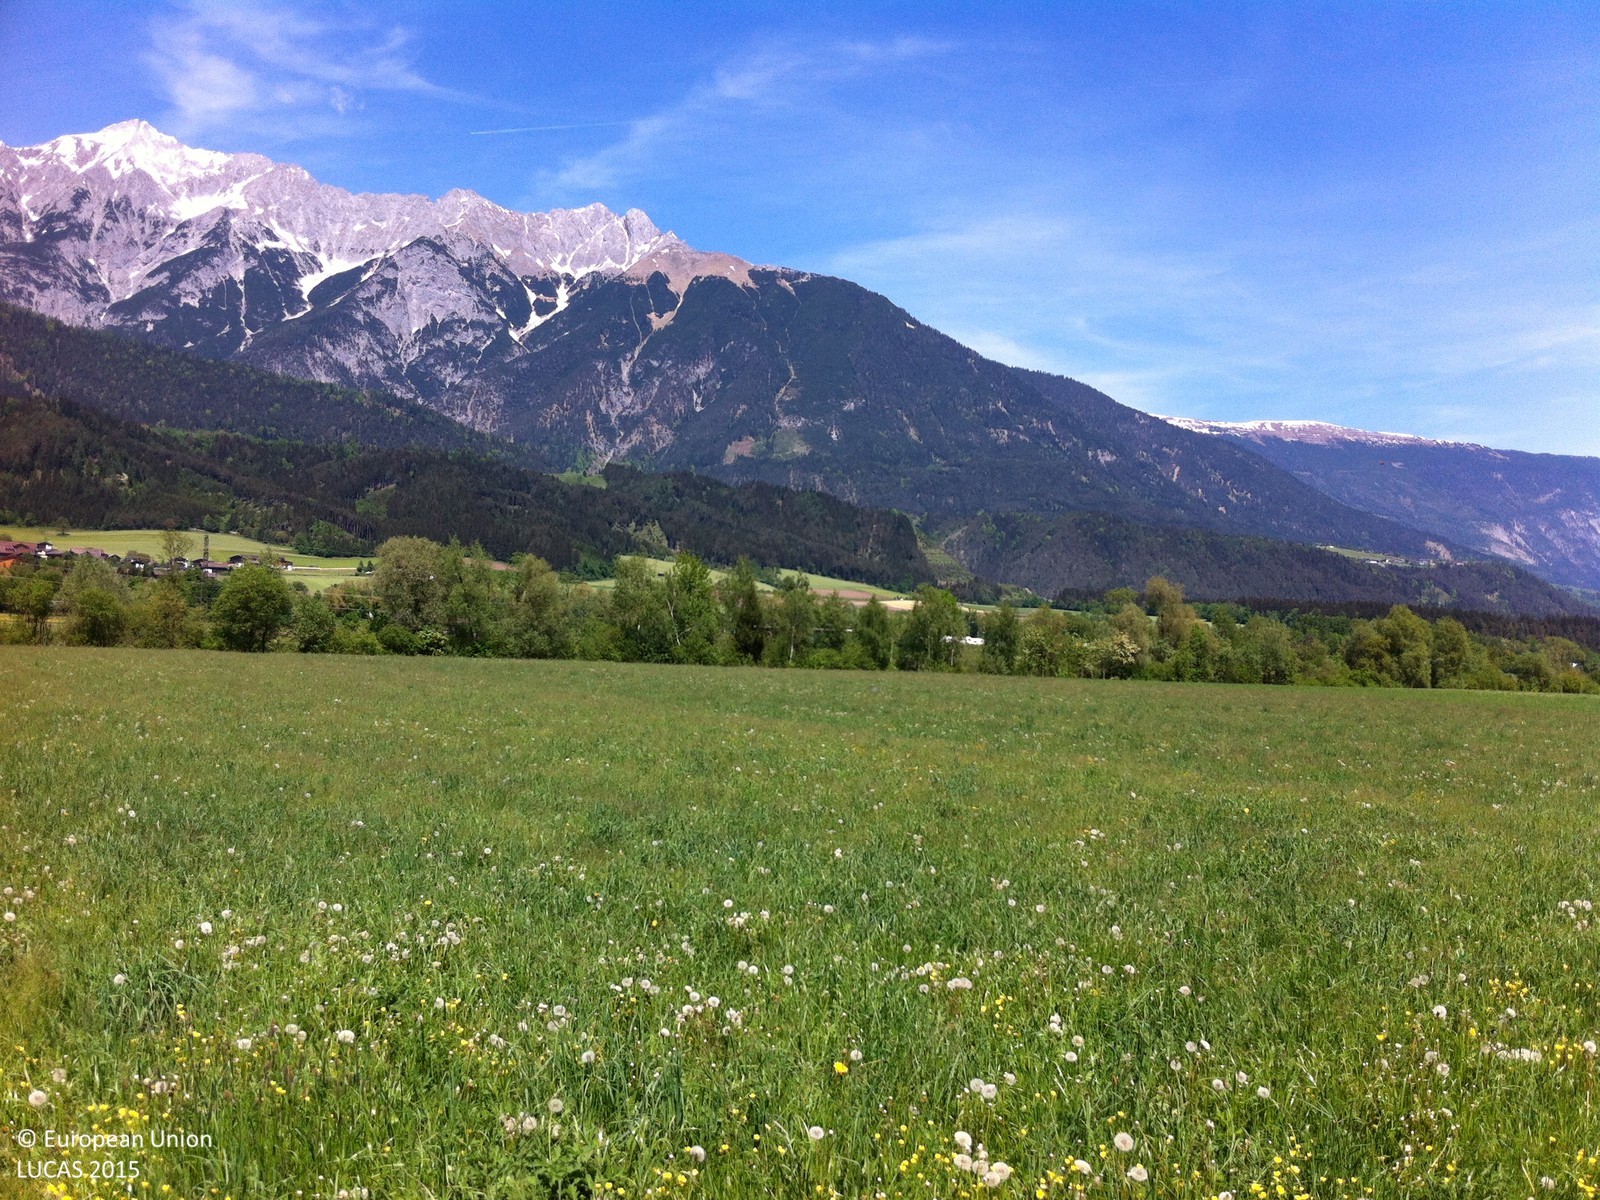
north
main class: Grassland
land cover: Grassland without tree/shrub cover
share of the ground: > 75 %
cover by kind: herbaceous plants 100 %
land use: Agriculture (excluding fallow land and kitchen gardens)
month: May
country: AT
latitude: 47.3111
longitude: 11.6521
